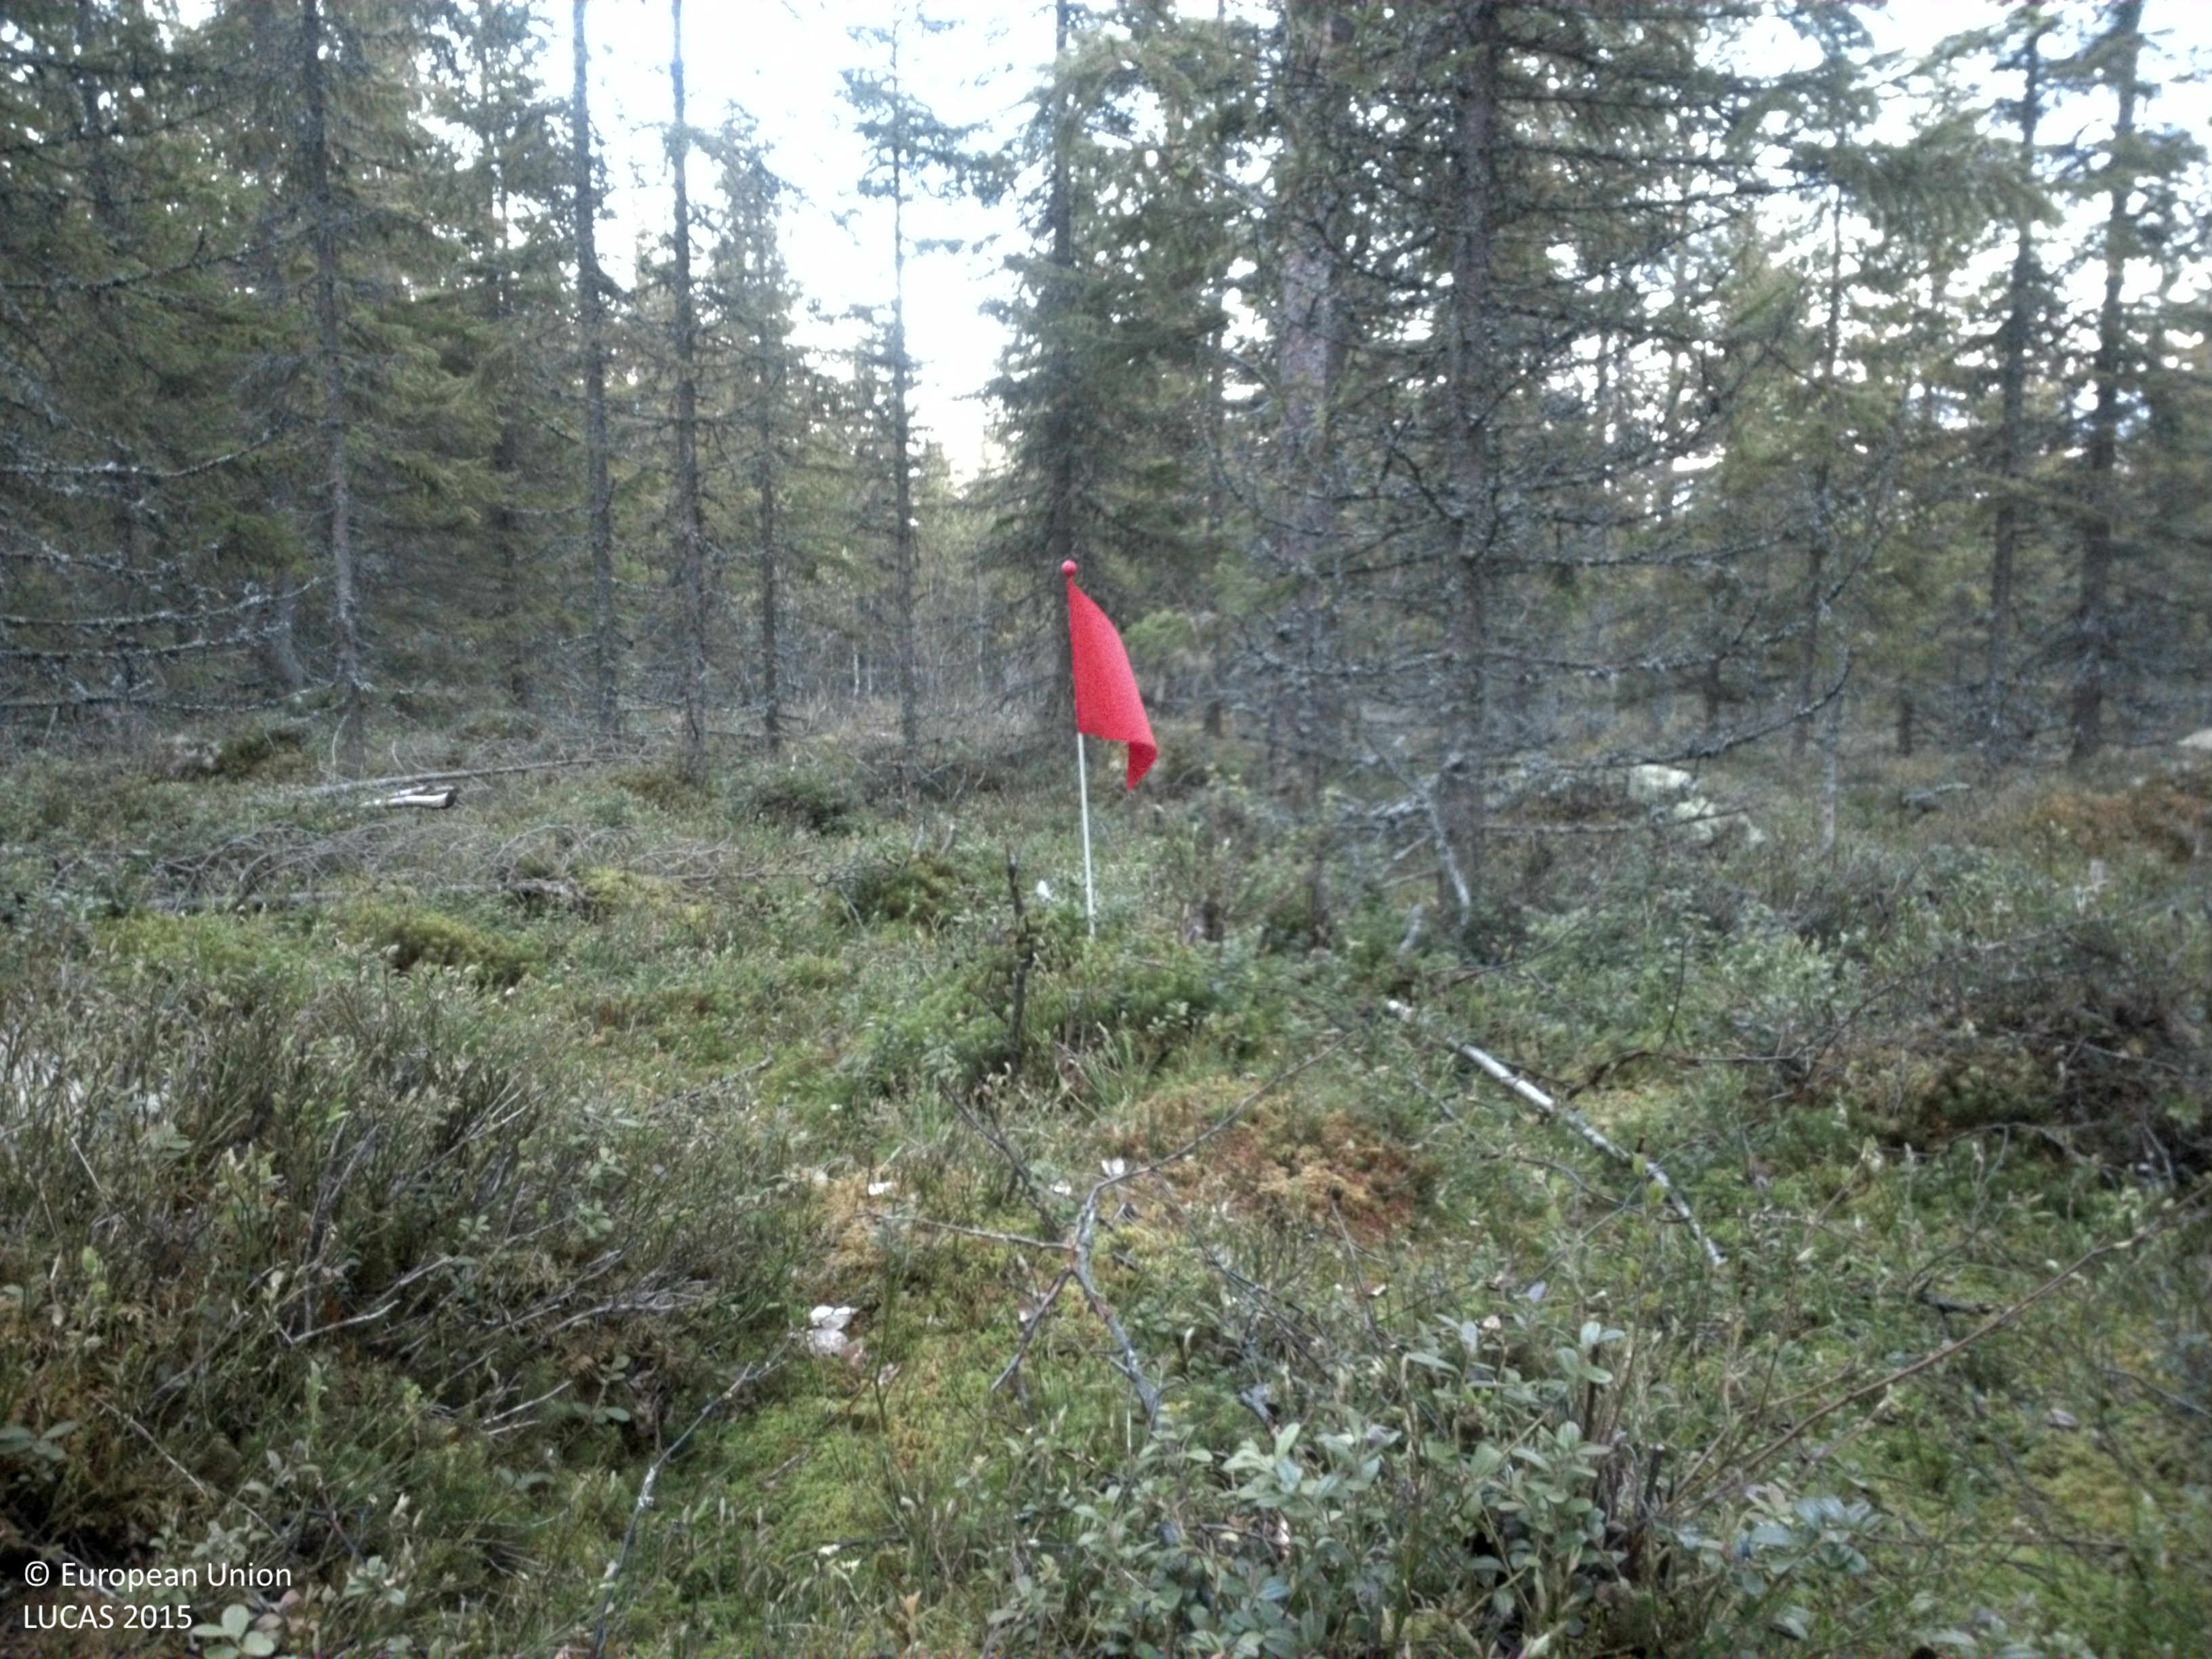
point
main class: Woodland
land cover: Spruce dominated coniferous woodland
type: boreal forest
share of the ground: > 75 %
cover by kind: coniferous forest trees 80 %, shrubs 20 %
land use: Forestry
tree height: > 5 m
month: May
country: SE
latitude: 60.9346
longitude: 12.4089
